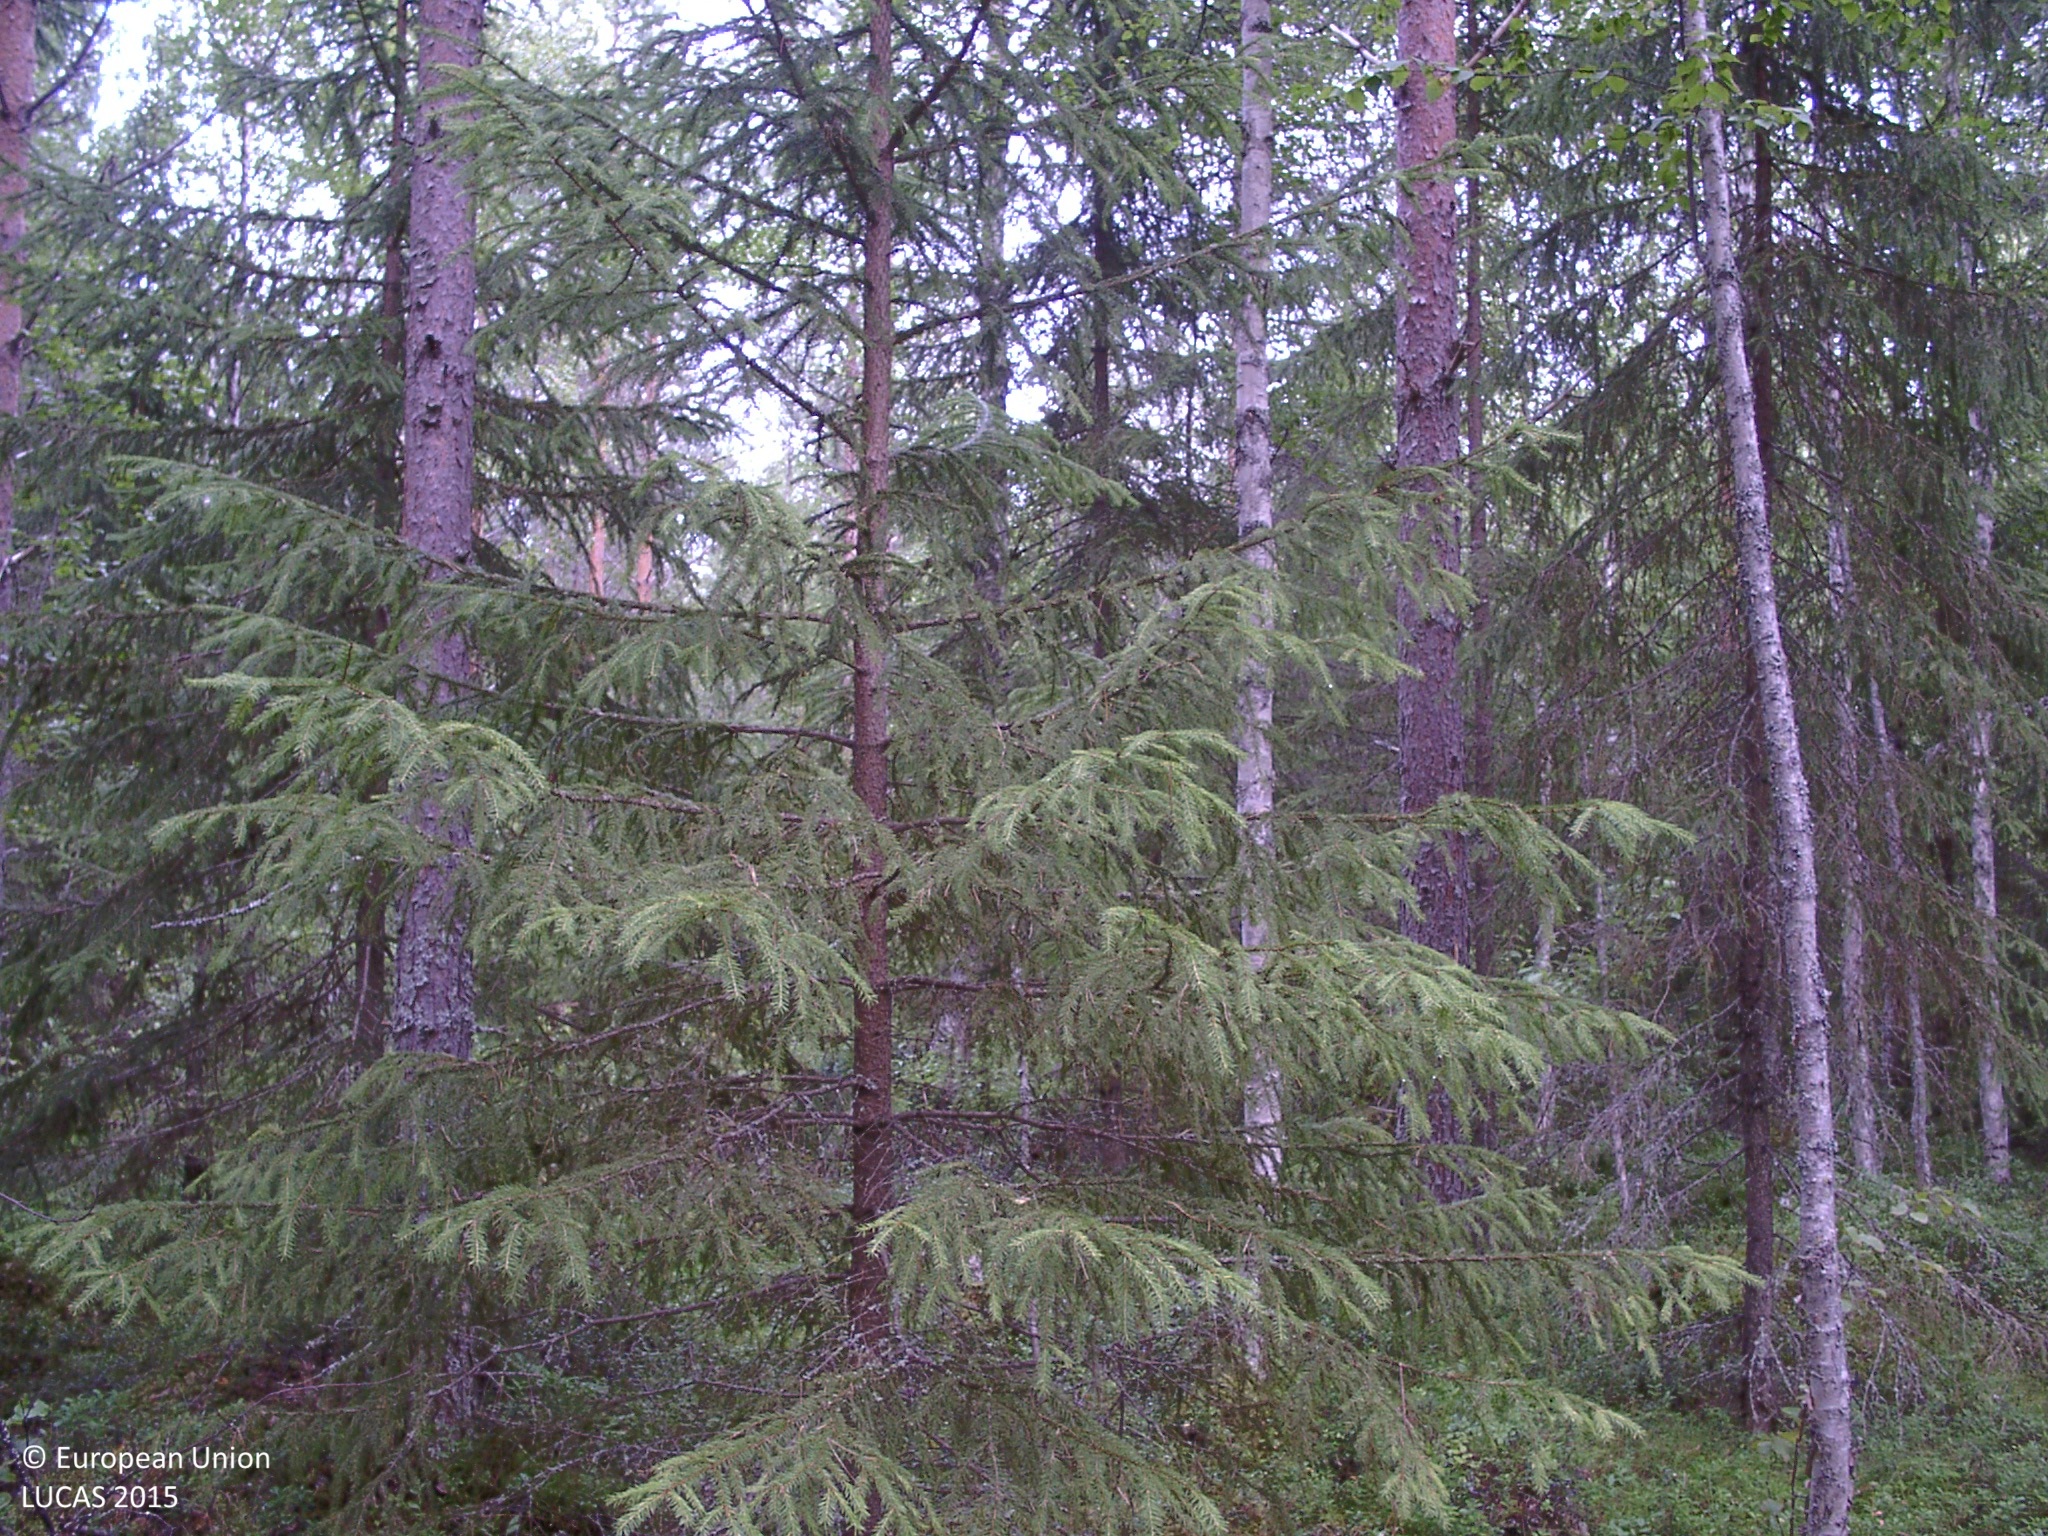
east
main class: Woodland
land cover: Other mixed woodland
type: boreal forest
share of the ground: > 75 %
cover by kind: coniferous forest trees 45 %, broadleaved forest trees 30 %, shrubs 20 %, lichens and mosses 5 %
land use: Forestry
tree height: > 5 m
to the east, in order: Other mixed woodland; Shruby margins; Other mixed woodland; Shruby margins; Spruce dominated mixed woodland; Broadleaved woodland; Ditches and canals; Broadleaved woodland; Ditches and canals; Managed hedges; Tracks; Managed hedges; Ditches and canals; Broadleaved woodland; Ditches and canals; Broadleaved woodland
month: August
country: FI
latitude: 63.0069
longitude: 25.0861
